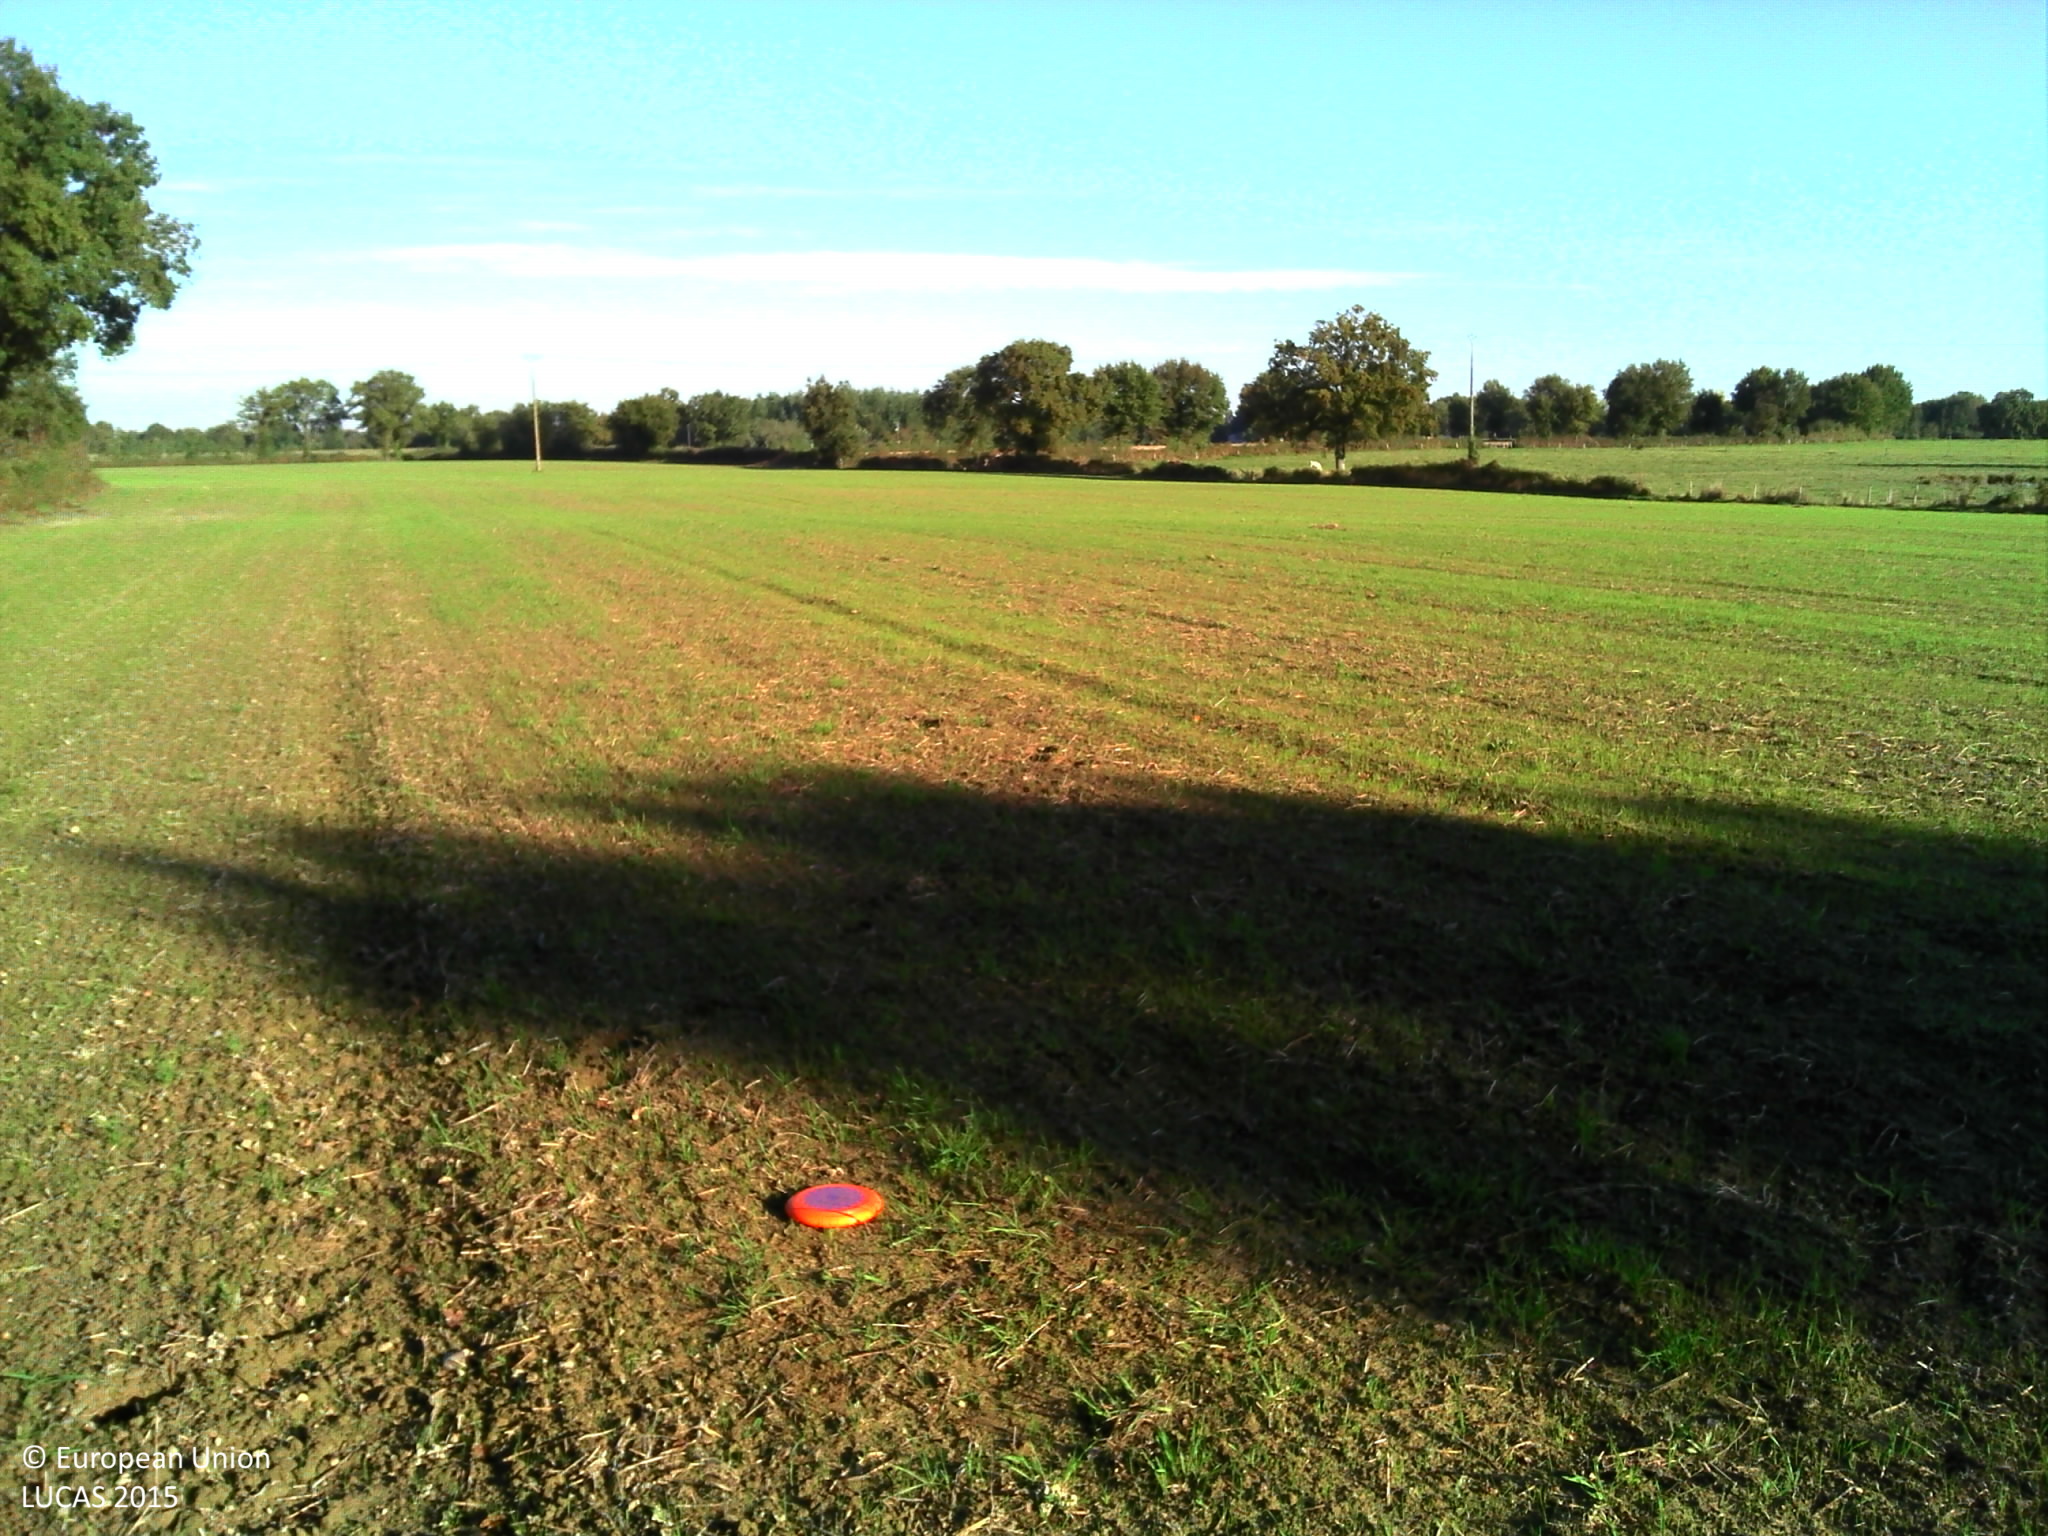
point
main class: Cropland
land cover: Common wheat
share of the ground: > 75 %
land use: Agriculture (excluding fallow land and kitchen gardens)
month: September
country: FR
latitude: 46.5757
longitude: -1.4021
